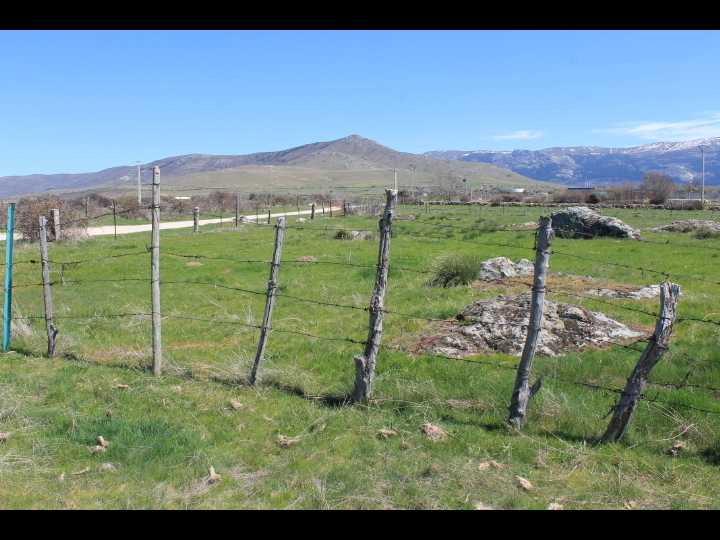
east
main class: Grassland
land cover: Grassland without tree/shrub cover
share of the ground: > 75 %
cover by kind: herbaceous plants 100 %
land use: Agriculture (excluding fallow land and kitchen gardens)
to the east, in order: Grassland without tree/shrub cover; Fences; Grassland without tree/shrub cover; Shruby margins; Grassland without tree/shrub cover; Fences; Grassland without tree/shrub cover; Tracks; Grass margins; Ditches and canals; Shruby margins; Fences; Grassland without tree/shrub cover; Other structural elements; Grassland without tree/shrub cover; Shruby margins; Fences; Grassland without tree/shrub cover; Electric lines; Grassland without tree/shrub cover; Tracks; Grassland without tree/shrub cover
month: April
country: ES
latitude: 40.9364
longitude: -4.0522
